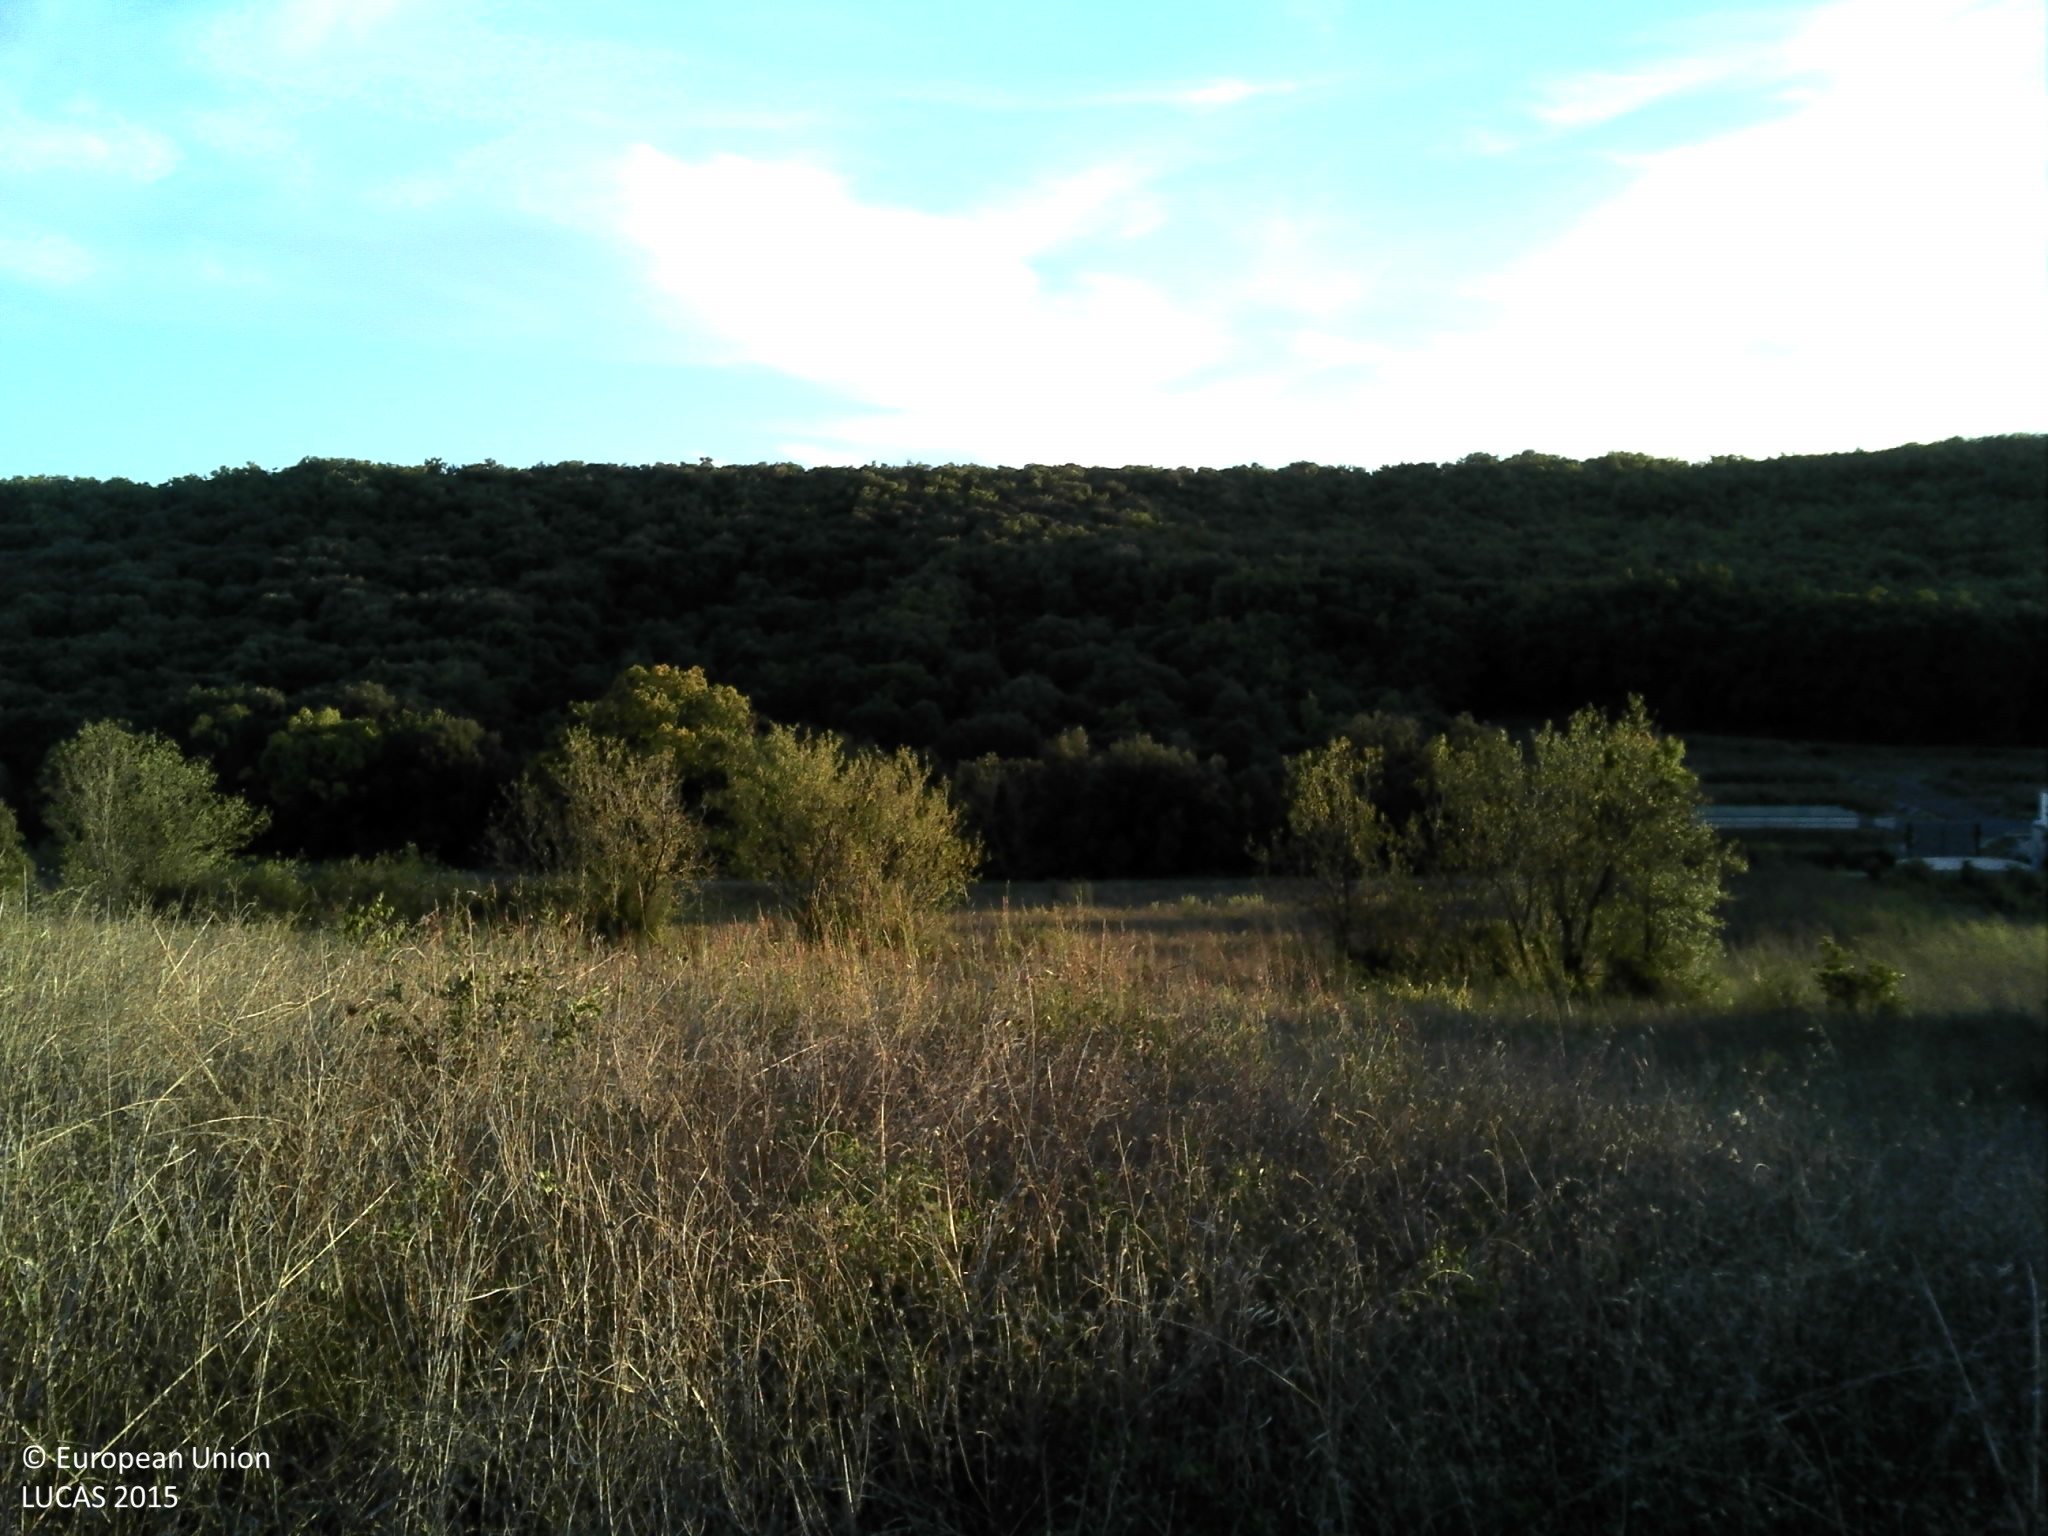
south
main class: Grassland
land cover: Spontaneously vegetated surfaces
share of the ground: > 75 %
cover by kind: herbaceous plants 95 %, shrubs 5 %
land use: Abandoned areas
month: October
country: FR
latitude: 43.5080
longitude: 3.4163
